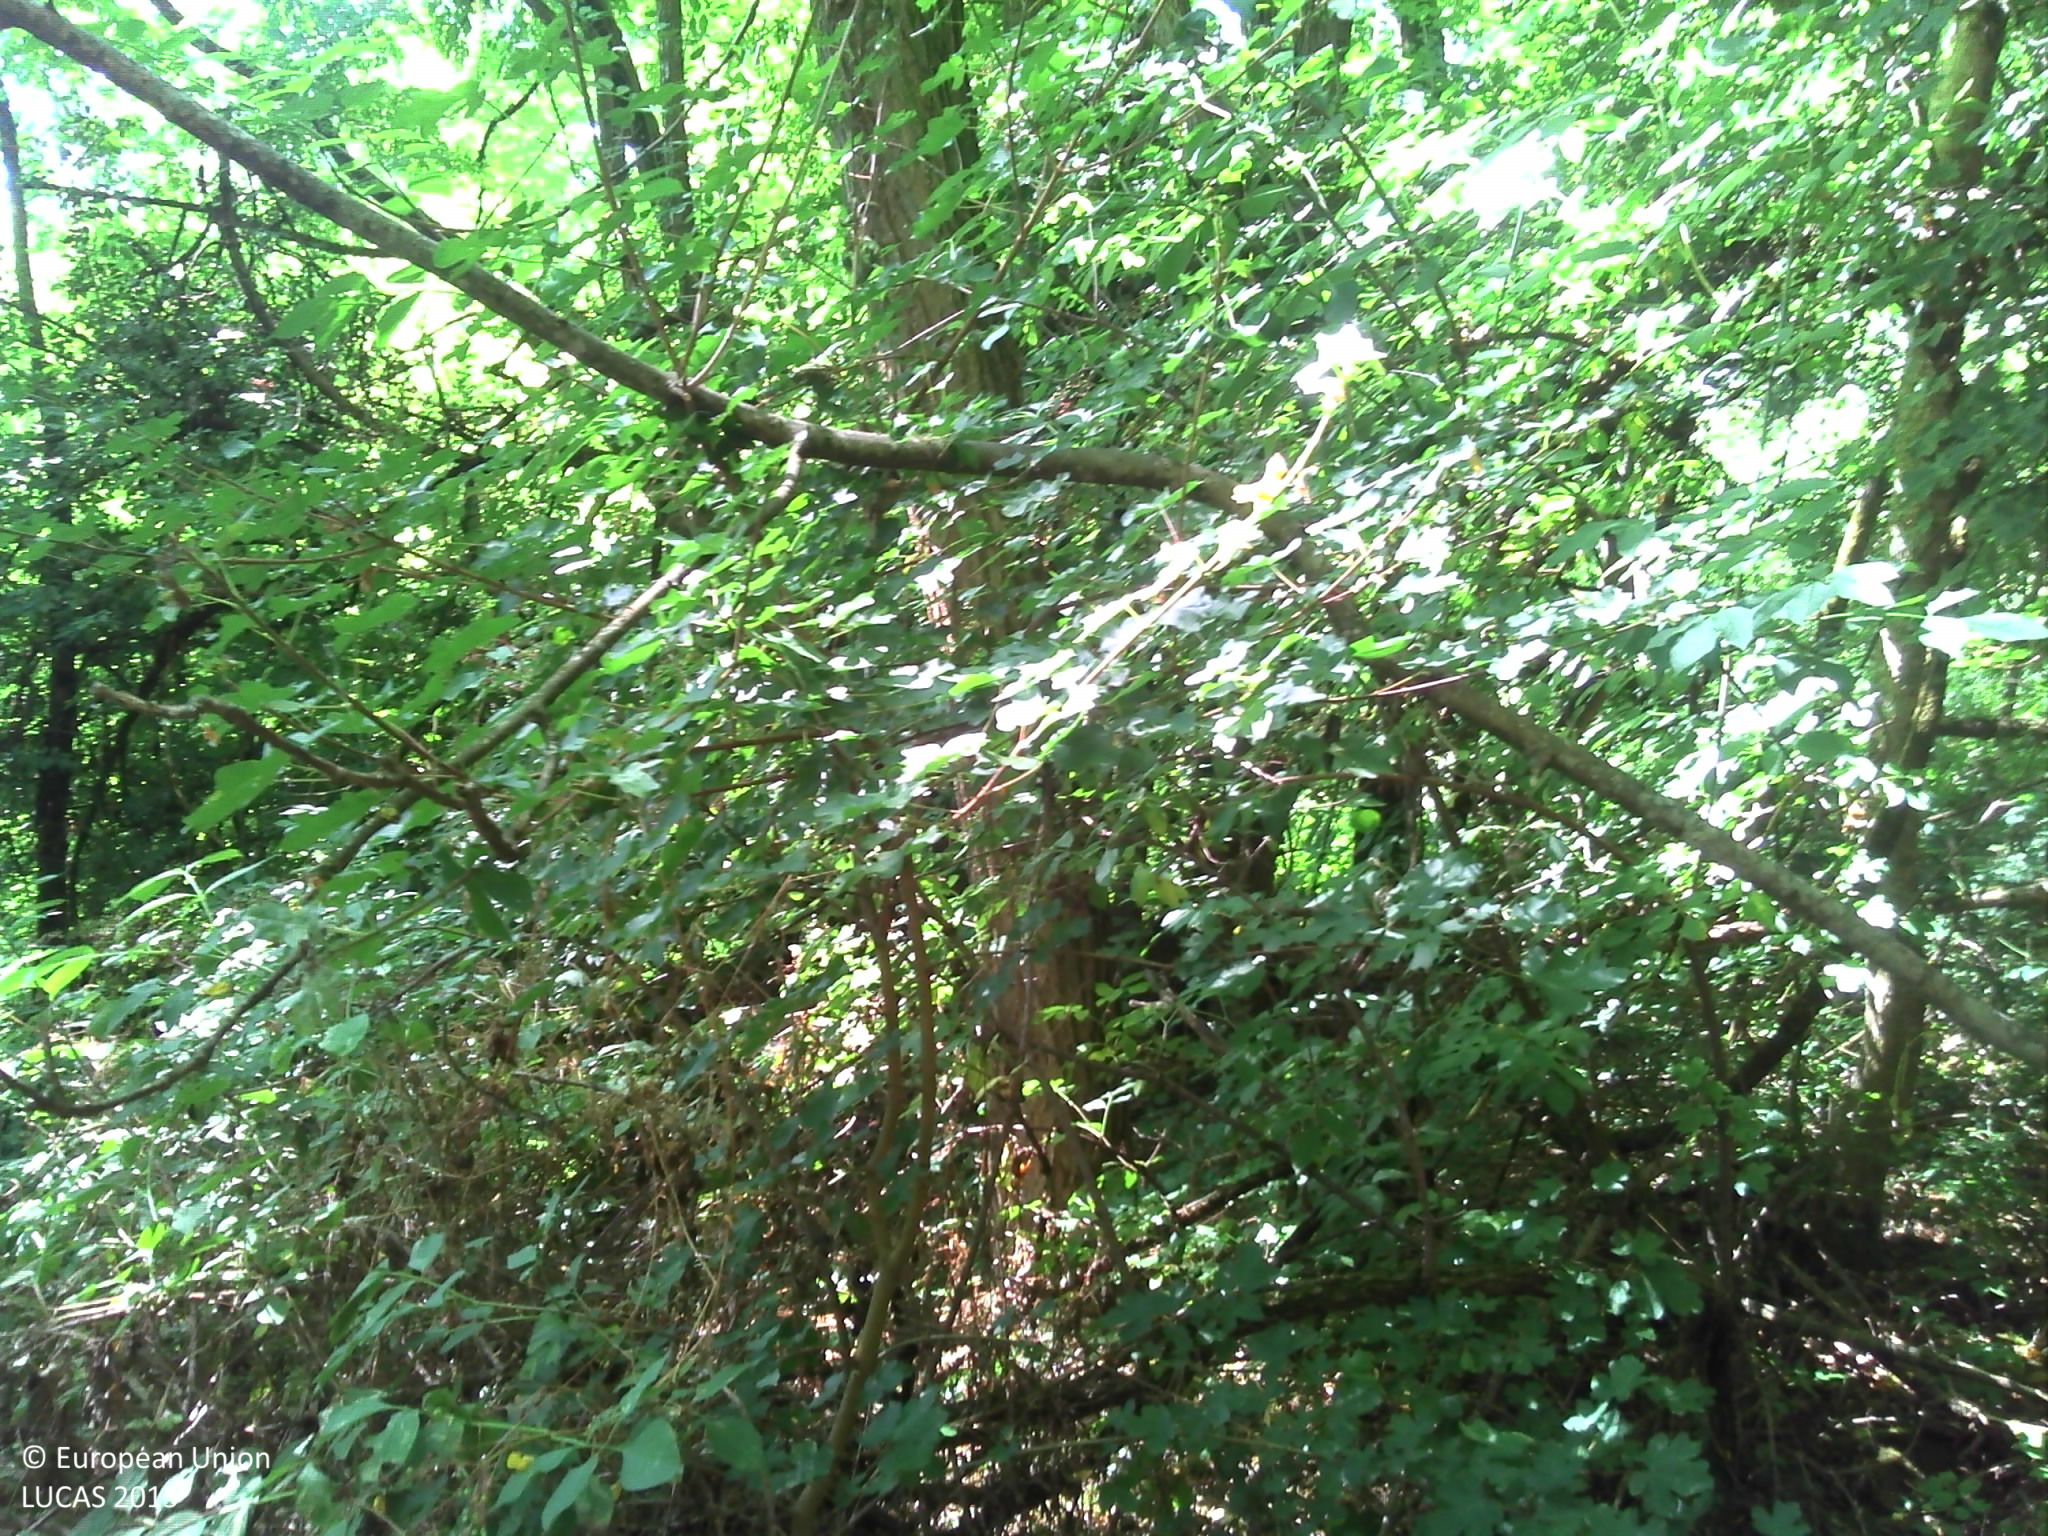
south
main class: Woodland
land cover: Broadleaved woodland
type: mesophytic deciduous forest
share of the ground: > 75 %
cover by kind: broadleaved forest trees 60 %, shrubs 20 %, herbaceous plants 20 %
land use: Semi-natural and natural areas not in use
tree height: > 5 m
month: July
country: FR
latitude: 45.9619
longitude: 4.5962
